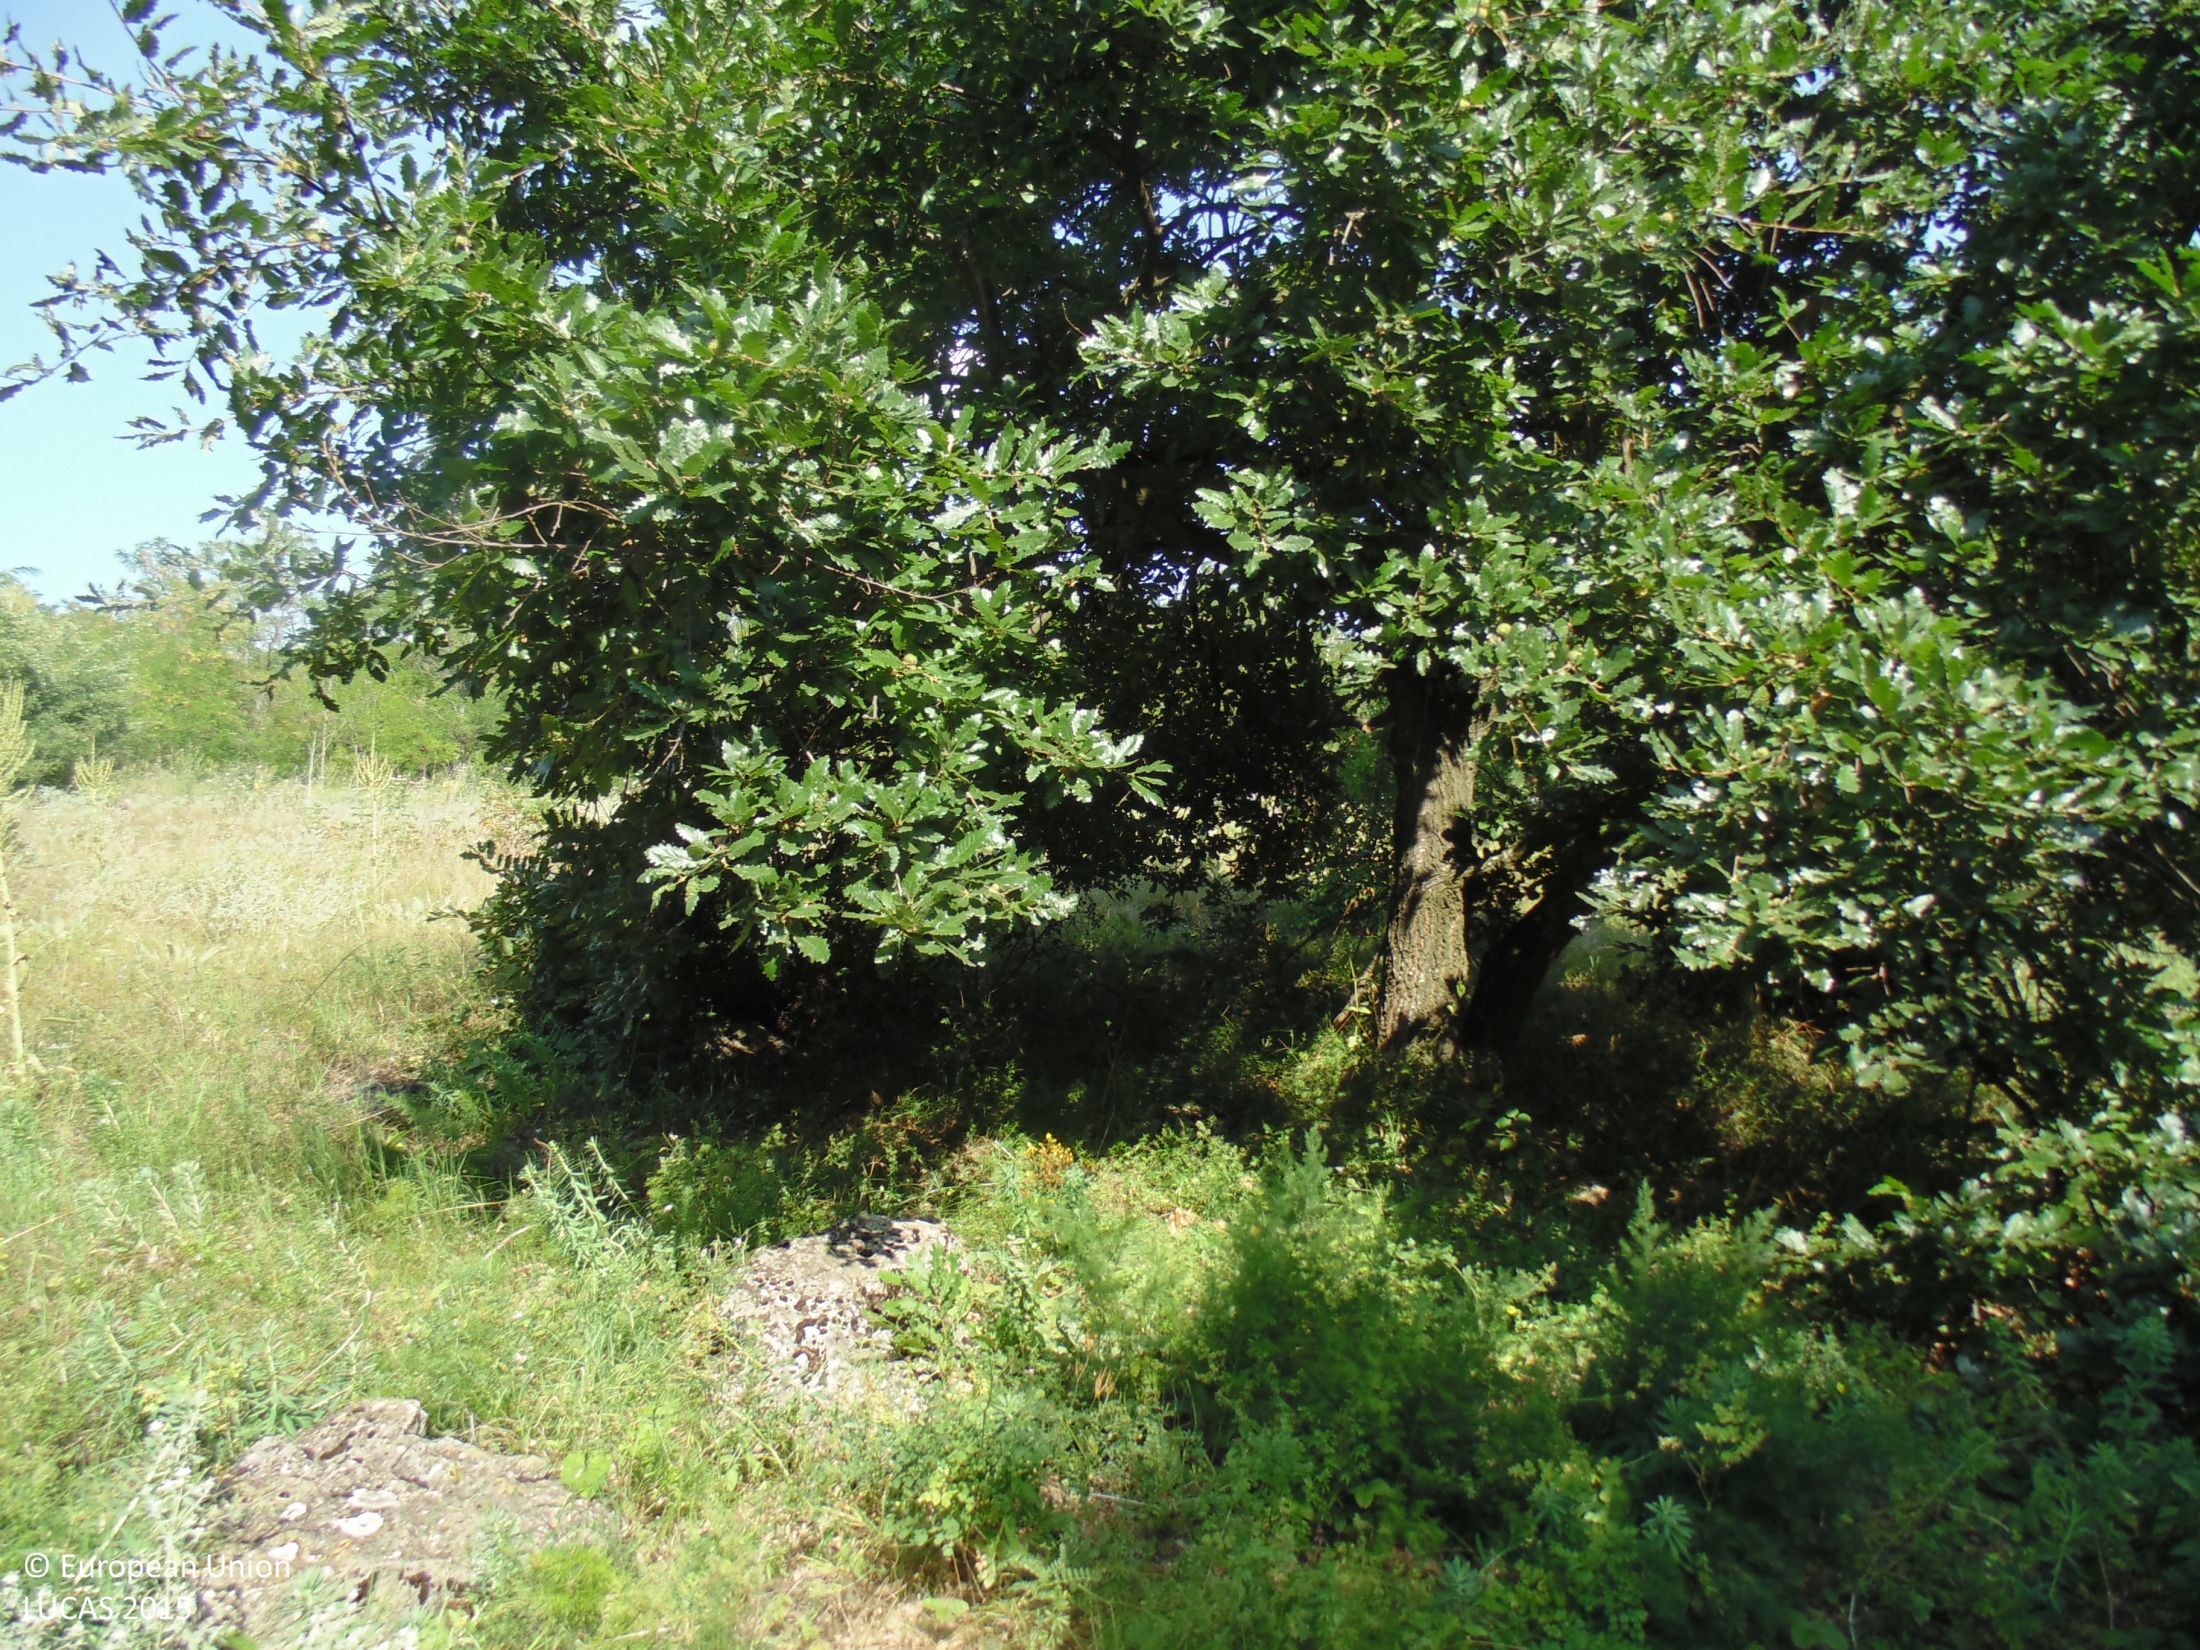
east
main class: Woodland
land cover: Broadleaved woodland
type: mesophytic deciduous forest
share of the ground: > 75 %
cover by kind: broadleaved forest trees 75 %, herbaceous plants 20 %, shrubs 5 %
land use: Forestry
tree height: > 5 m
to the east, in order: Broadleaved woodland; Grassland with sparse tree/shrub cover; Broadleaved woodland; Grass margins; Common wheat
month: July
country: BG
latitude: 43.5980
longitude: 27.5378
